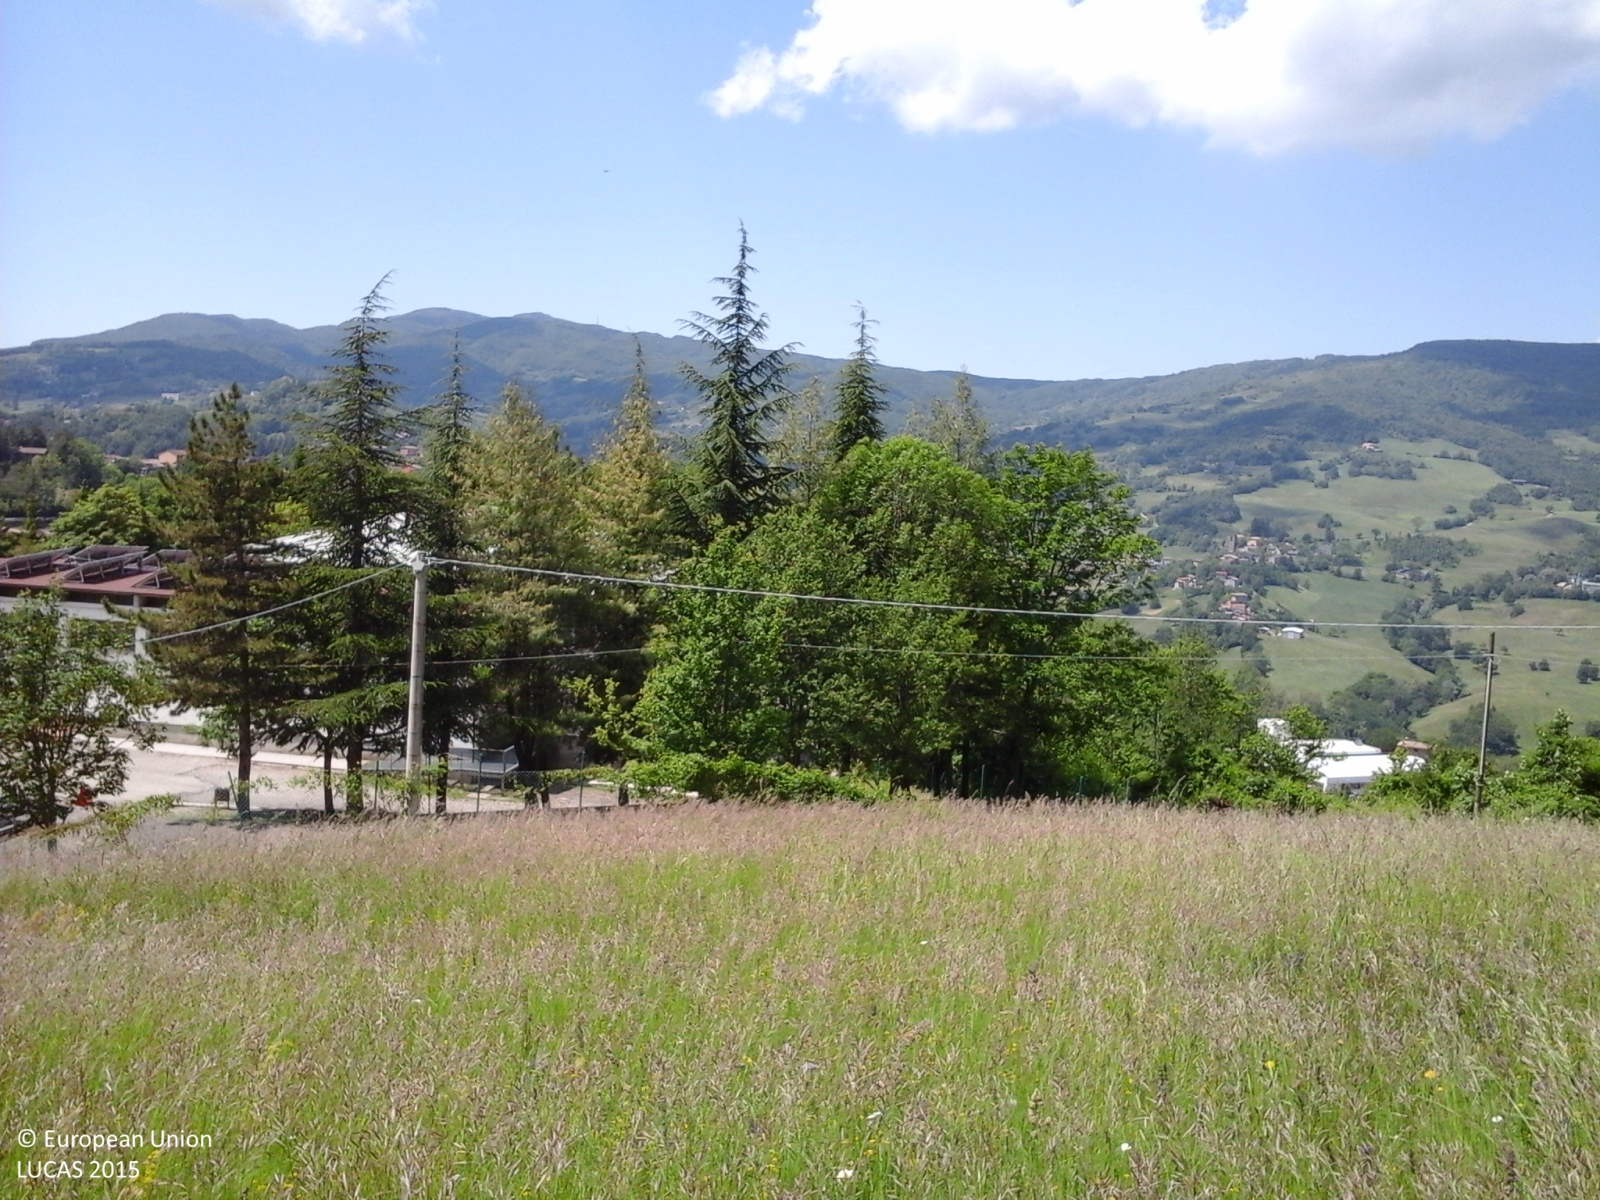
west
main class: Grassland
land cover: Grassland without tree/shrub cover
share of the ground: > 75 %
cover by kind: herbaceous plants 100 %
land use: Agriculture (excluding fallow land and kitchen gardens)
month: May
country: IT
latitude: 44.3118
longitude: 10.7379
